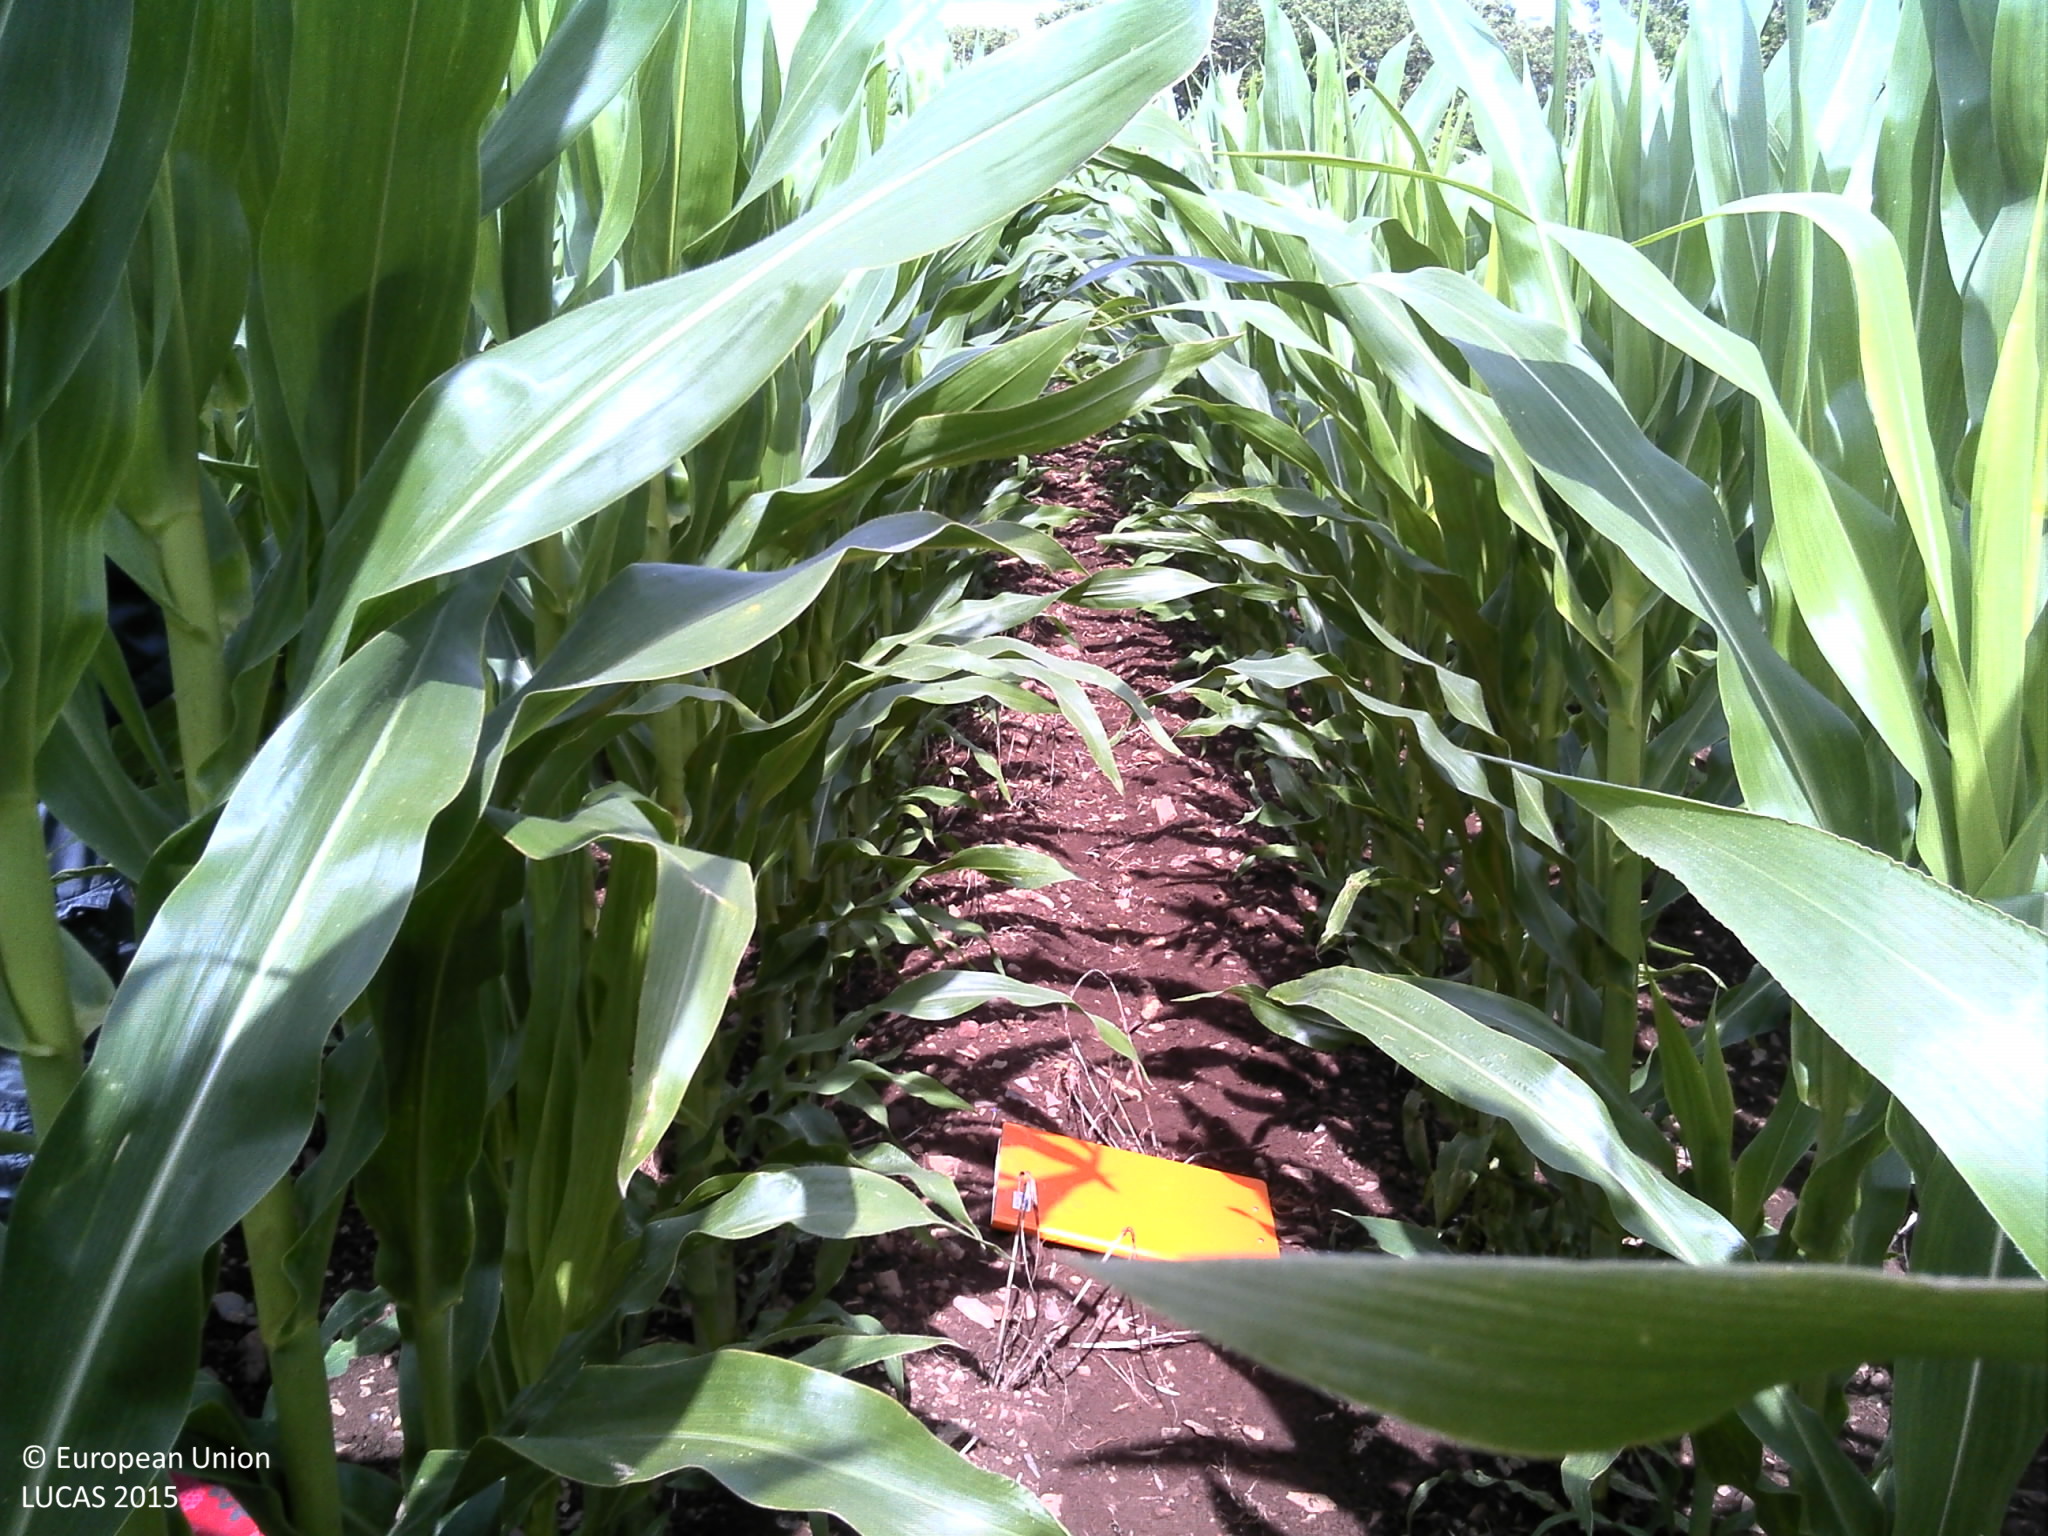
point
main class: Cropland
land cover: Maize
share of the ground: > 75 %
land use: Agriculture (excluding fallow land and kitchen gardens)
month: July
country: FR
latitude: 48.2528
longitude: -4.1653
